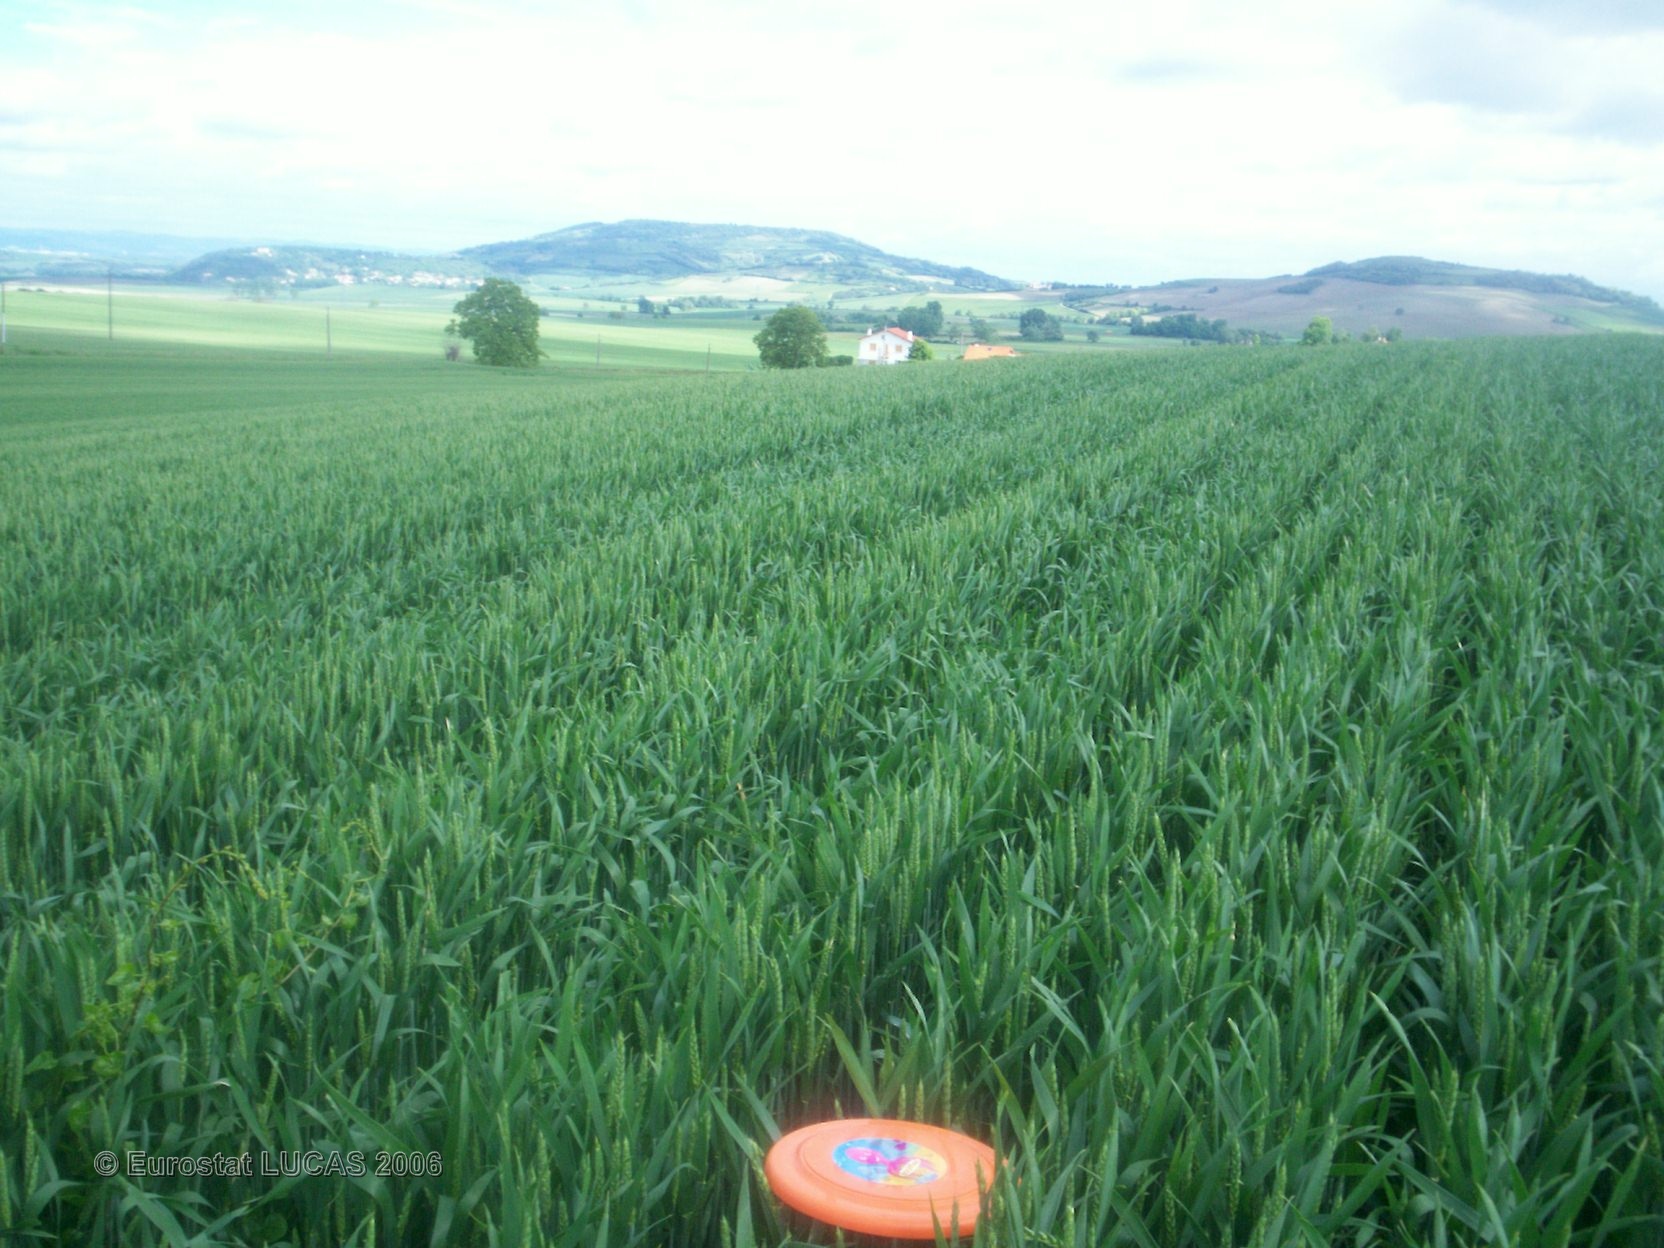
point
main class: Cropland
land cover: Common wheat
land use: Agriculture (excluding fallow land and kitchen gardens)
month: May
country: FR
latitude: 45.7062
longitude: 3.2828
